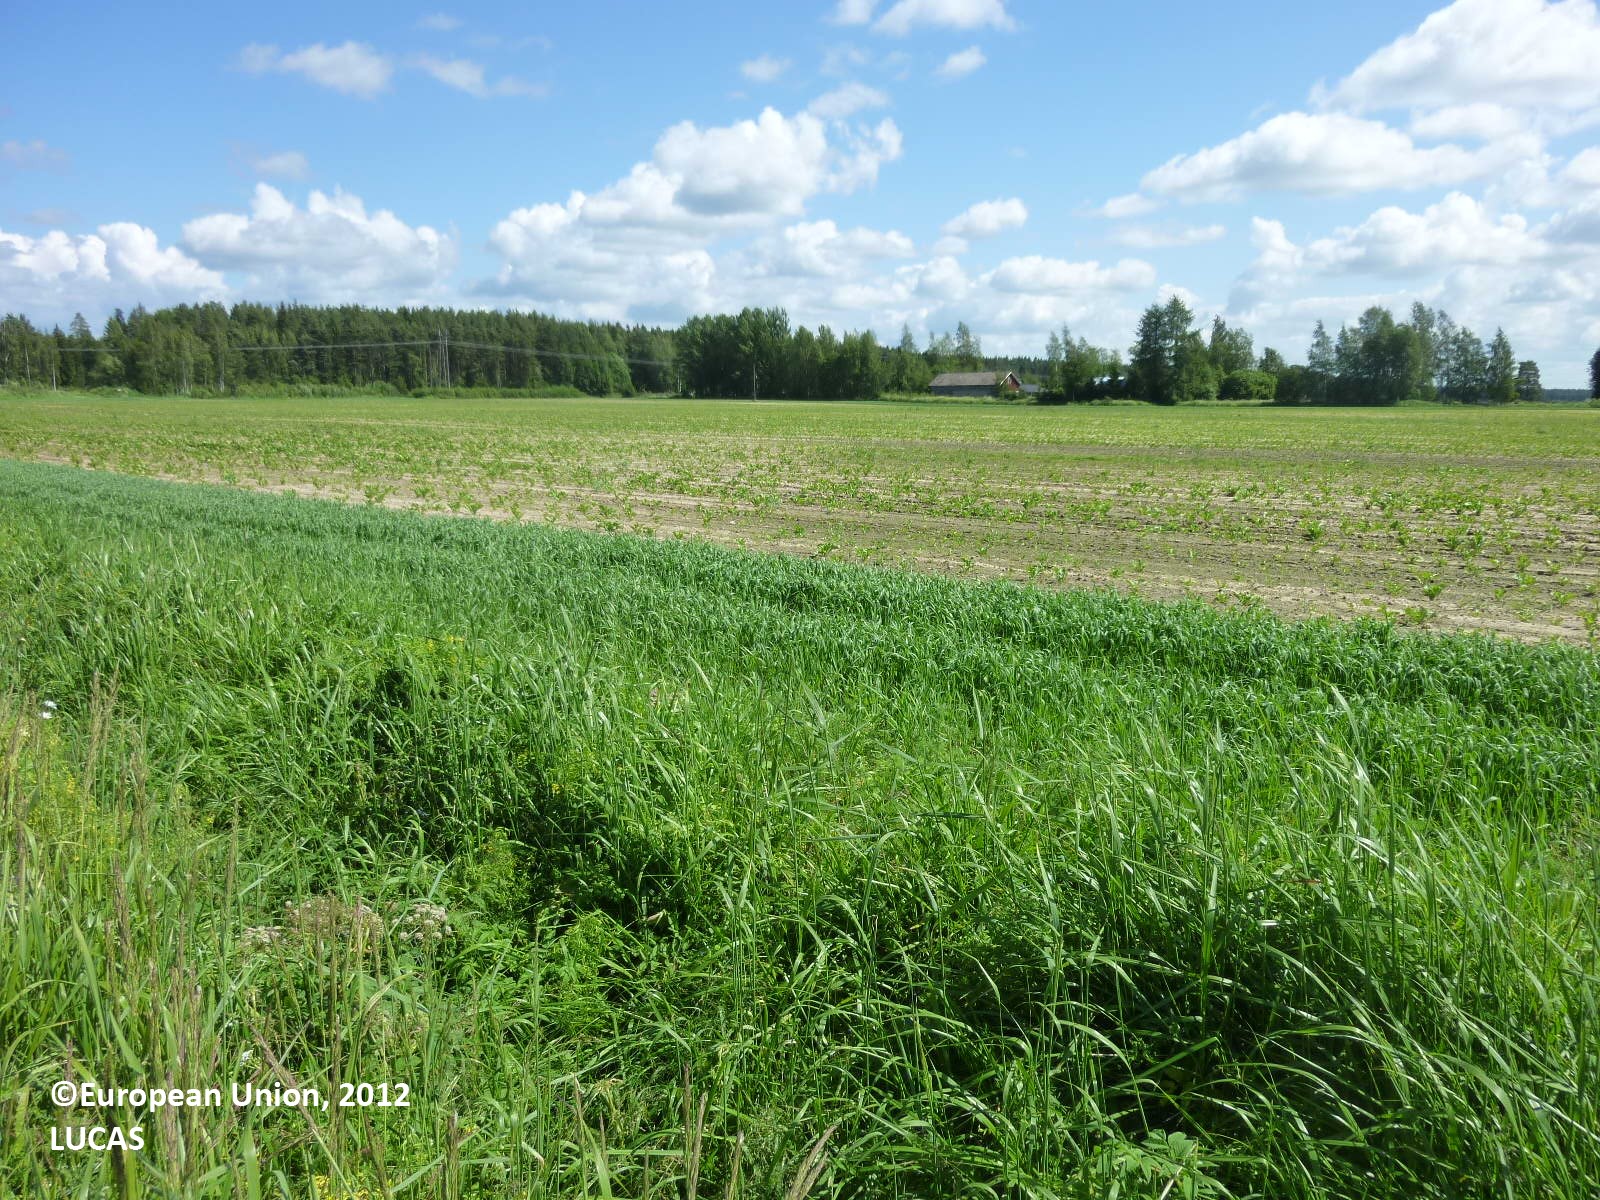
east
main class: Cropland
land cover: Potatoes
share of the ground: 25 - 50 %
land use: Agriculture (excluding fallow land and kitchen gardens)
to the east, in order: Potatoes; Grass margins; Ditches and canals; Grassland without tree/shrub cover; Sugar beet
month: July
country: FI
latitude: 61.3772
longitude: 22.0532
